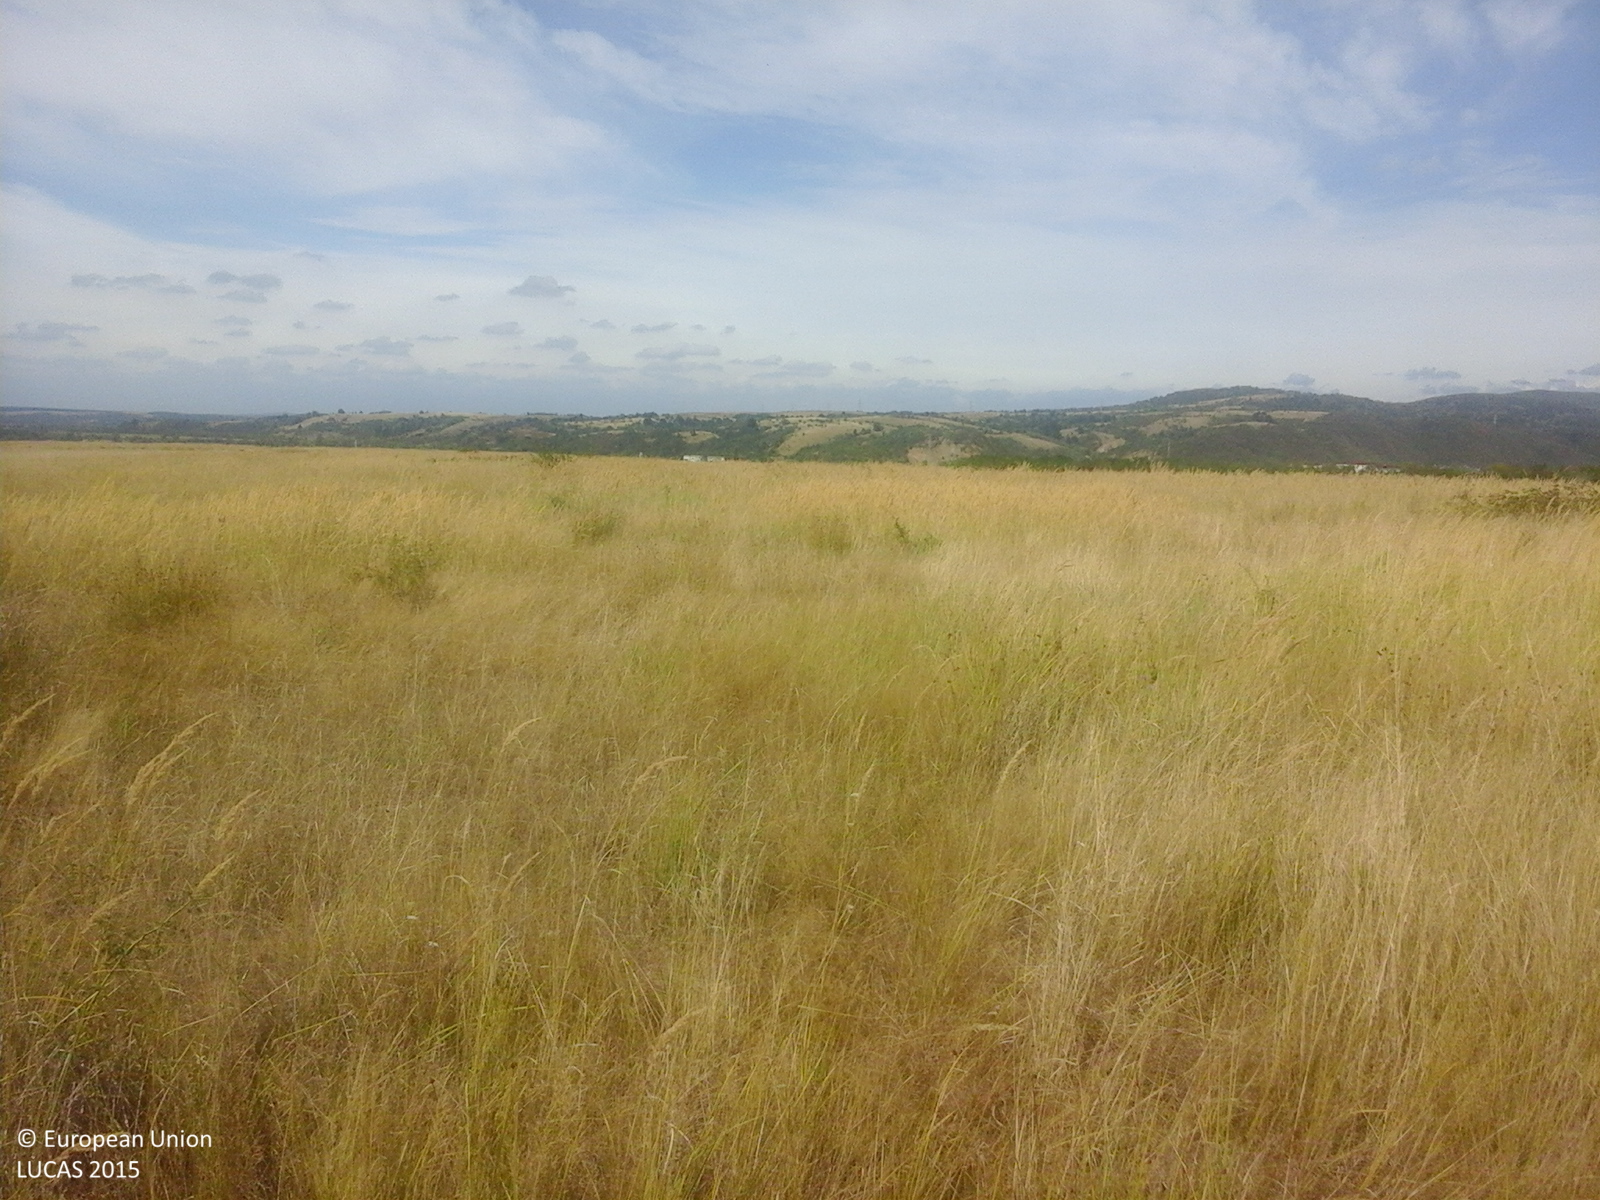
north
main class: Grassland
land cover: Spontaneously vegetated surfaces
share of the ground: > 75 %
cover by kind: herbaceous plants 100 %
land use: Fallow land
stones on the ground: < 10 %
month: August
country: RO
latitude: 45.3621
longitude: 21.6896
